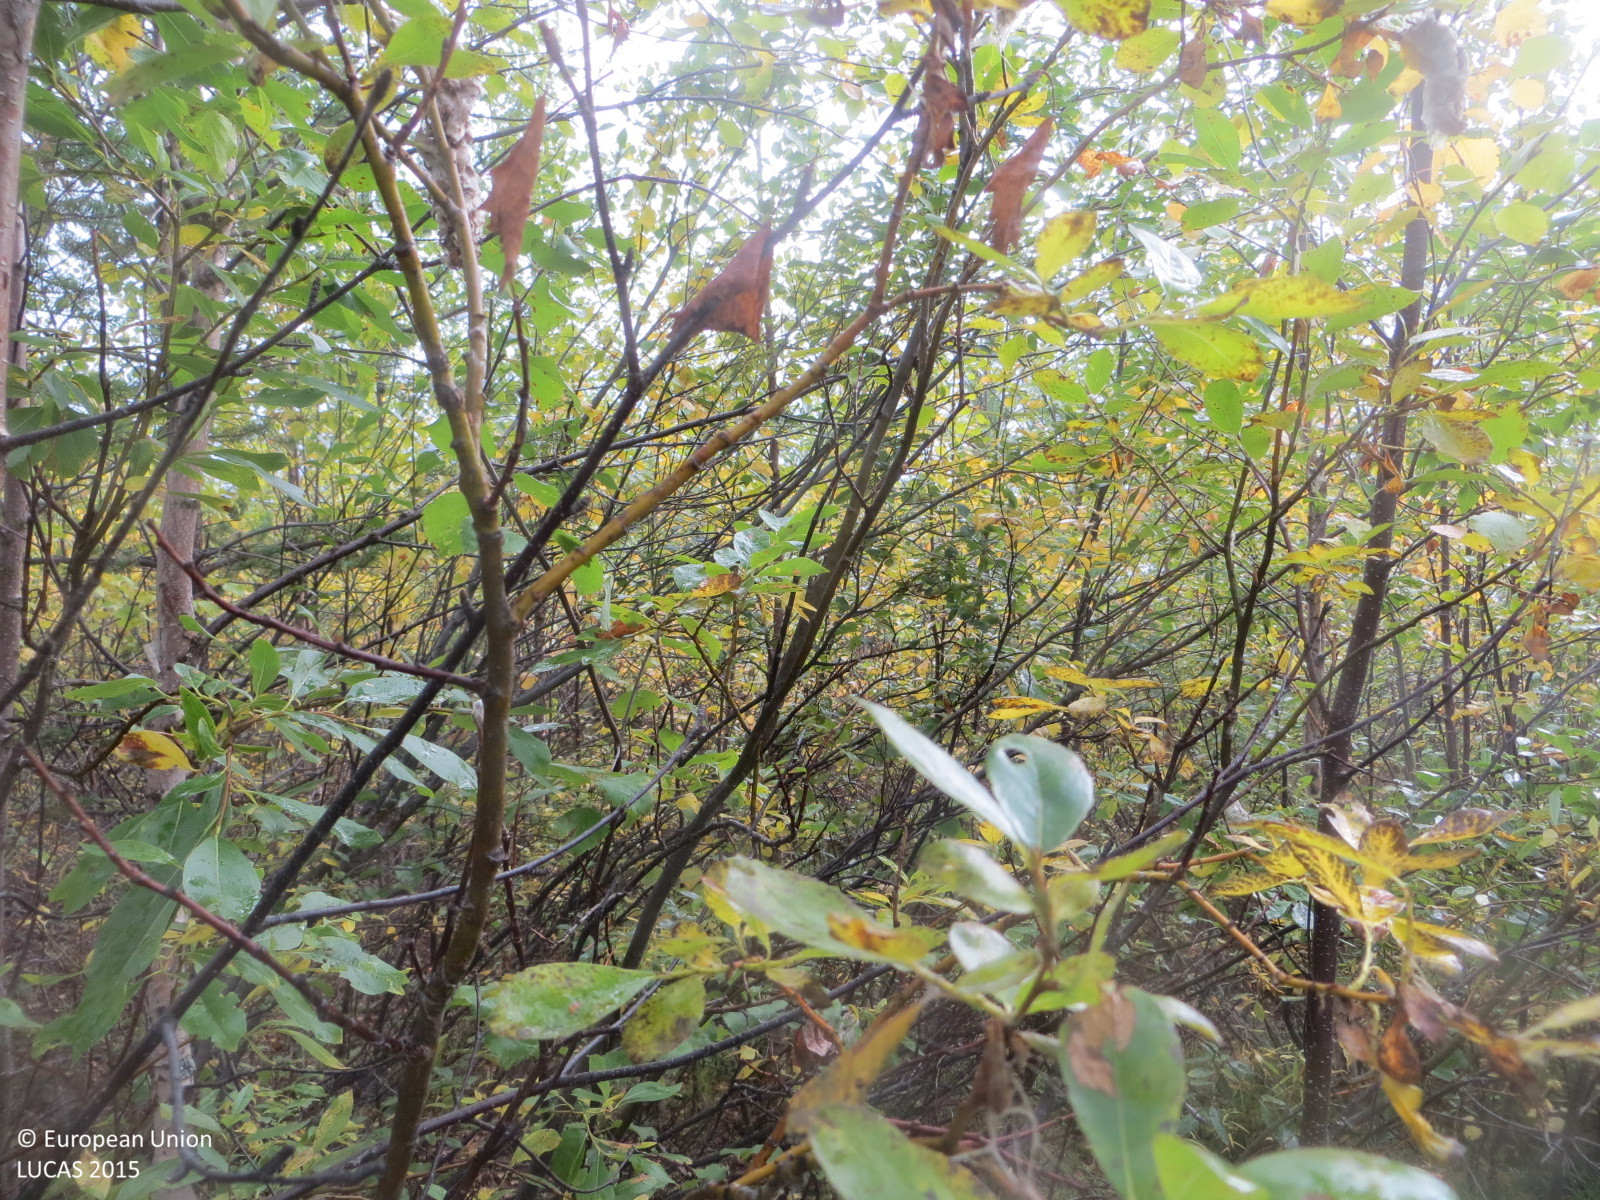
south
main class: Woodland
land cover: Pine dominated mixed woodland
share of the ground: > 75 %
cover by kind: coniferous forest trees 55 %, broadleaved forest trees 35 %, herbaceous plants 10 %
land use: Forestry
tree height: > 5 m
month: August
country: FI
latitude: 67.9941
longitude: 24.7349
